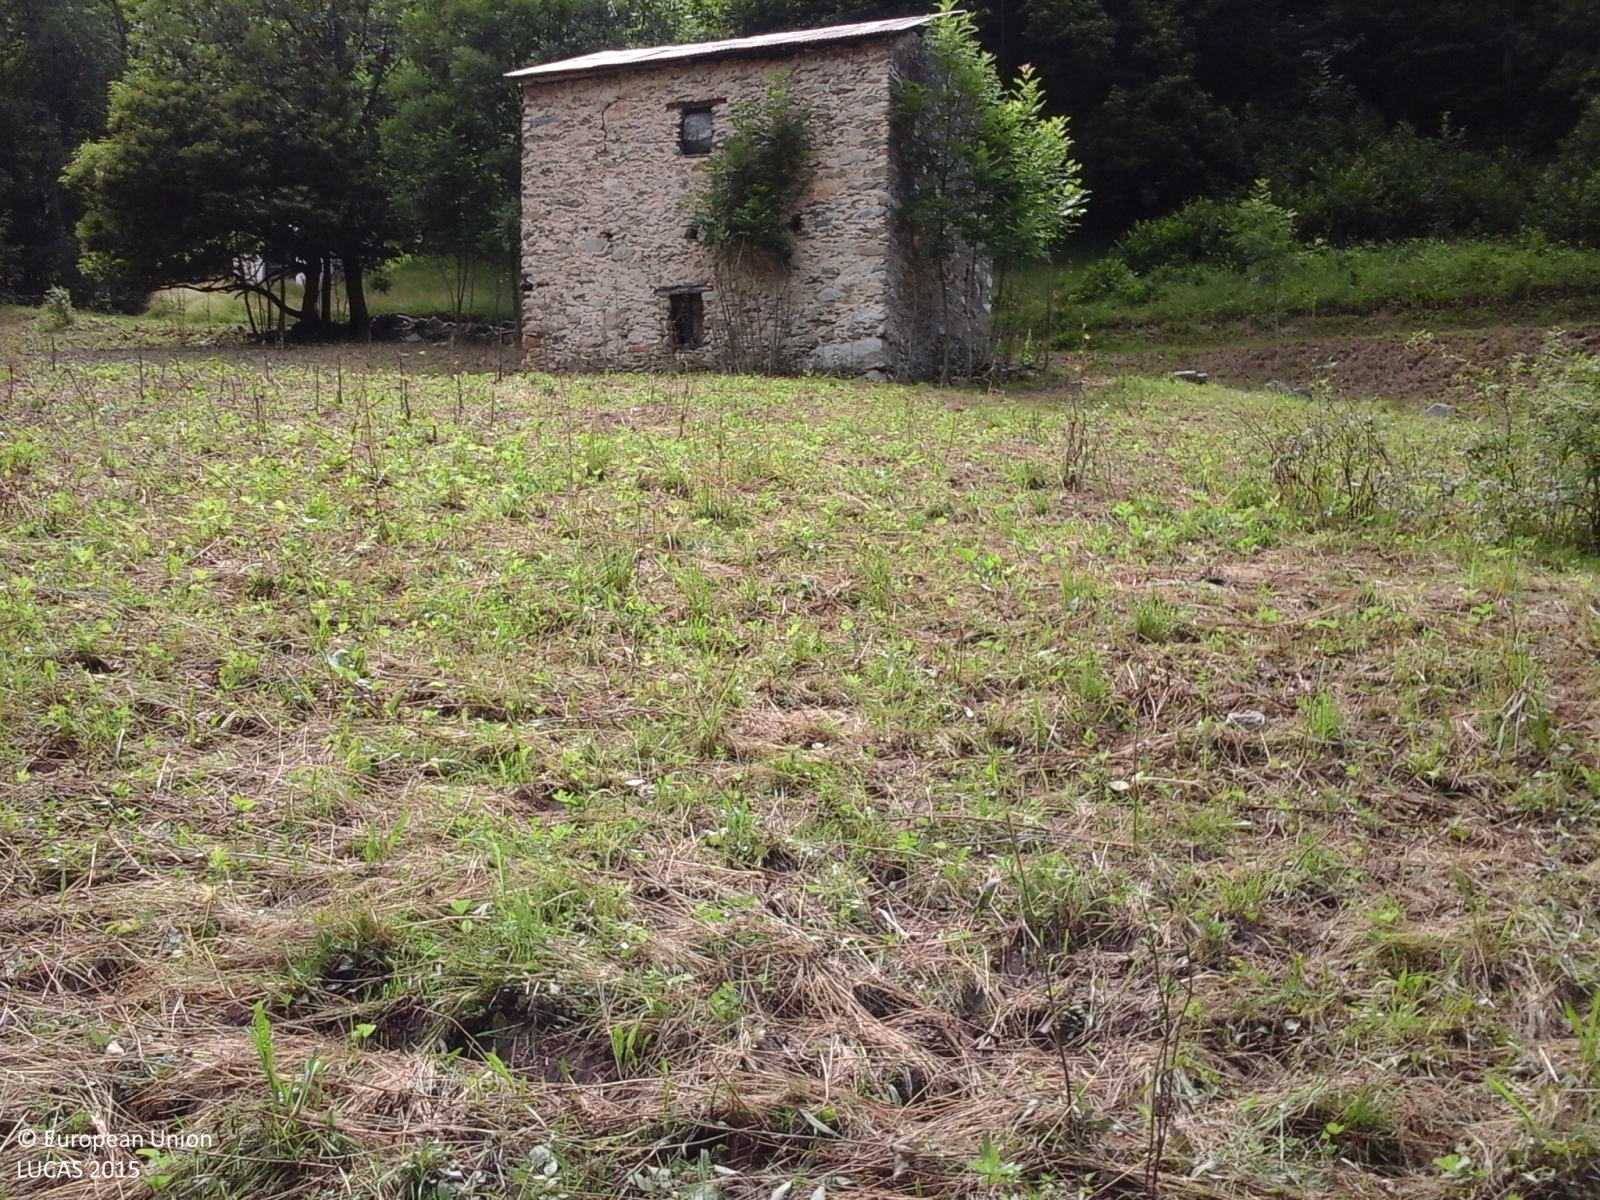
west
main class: Grassland
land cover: Grassland without tree/shrub cover
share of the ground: > 75 %
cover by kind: herbaceous plants 100 %
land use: Agriculture (excluding fallow land and kitchen gardens)
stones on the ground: < 10 %
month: June
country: IT
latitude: 44.2379
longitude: 7.8387
